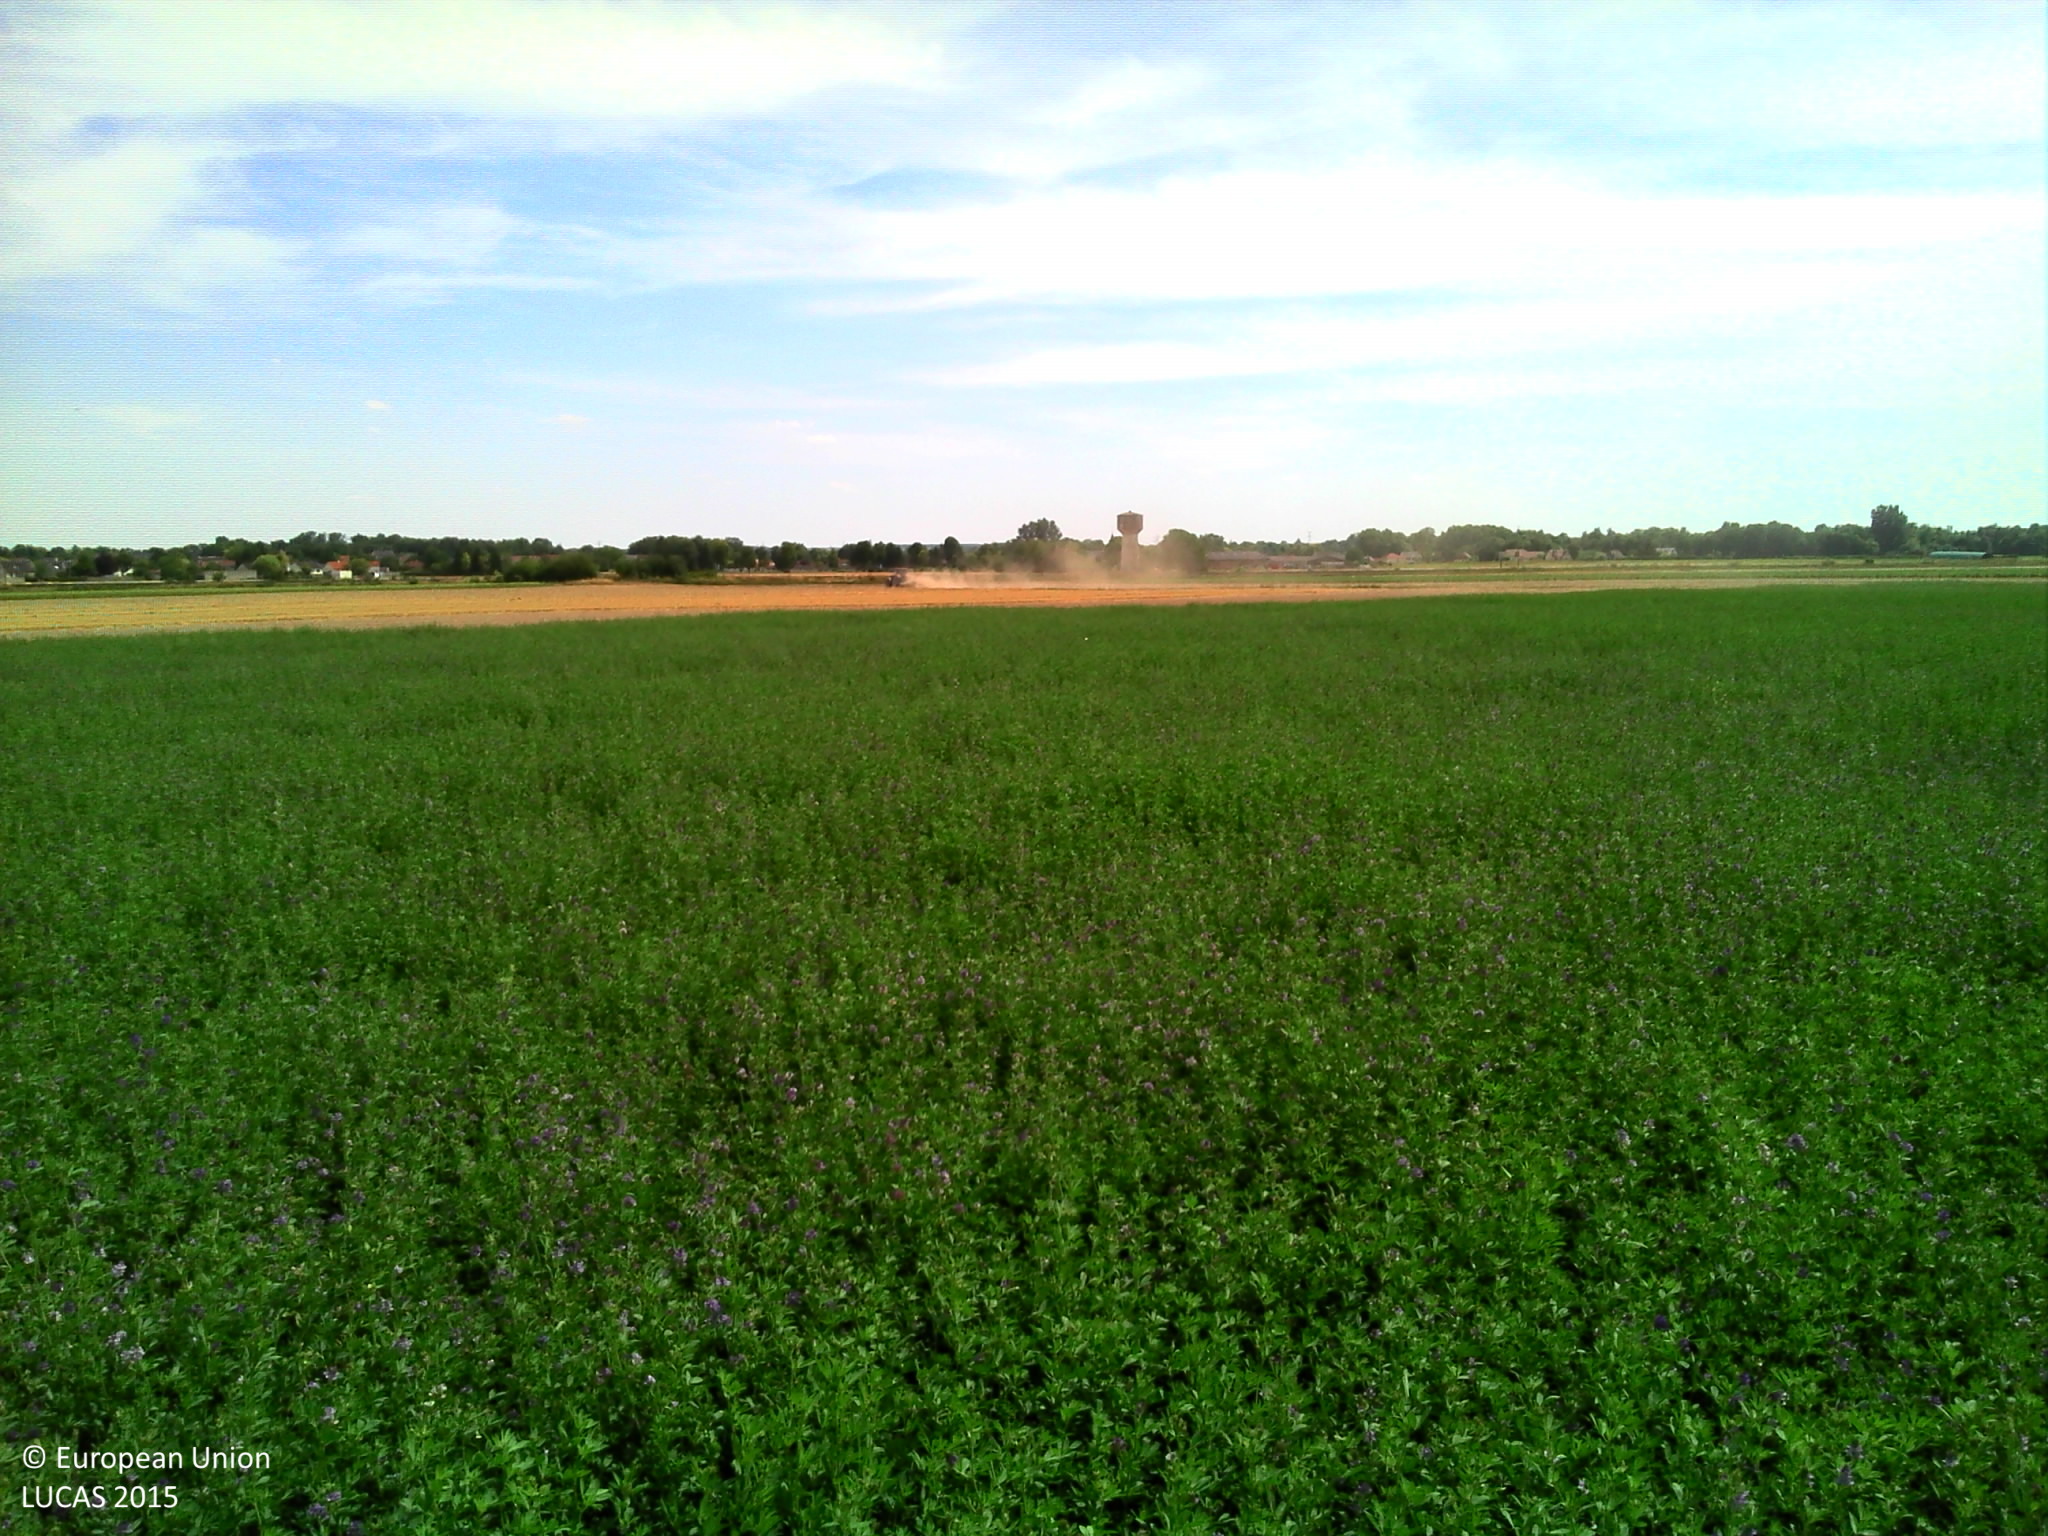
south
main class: Cropland
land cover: Lucerne
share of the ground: > 75 %
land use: Agriculture (excluding fallow land and kitchen gardens)
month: August
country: FR
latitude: 49.1406
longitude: 4.3073
